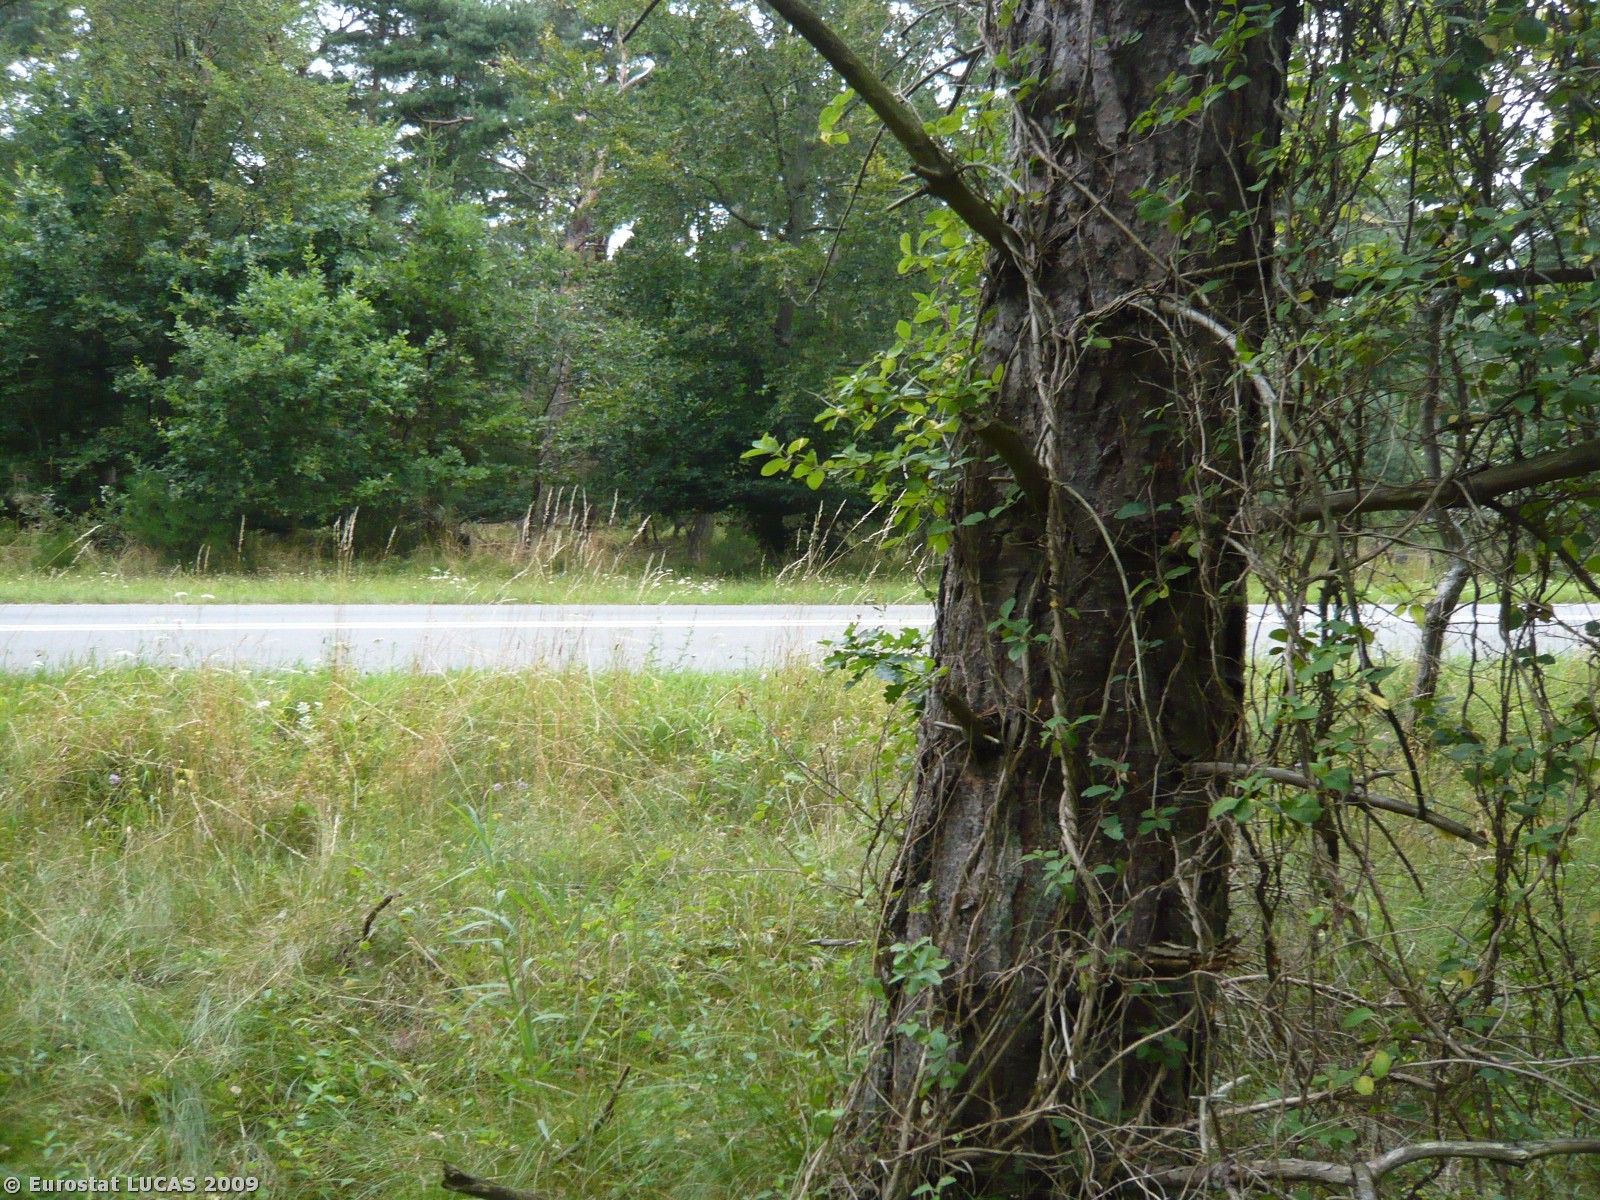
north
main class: Woodland
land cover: Coniferous woodland
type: hemiboreal forest and nemoral coniferous forest and mixed broadleaved-coniferous forest
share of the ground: > 75 %
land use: Residential
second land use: Amenities, museums, leisure
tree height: > 5 m
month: August
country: DK
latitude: 56.0103
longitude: 12.0029
